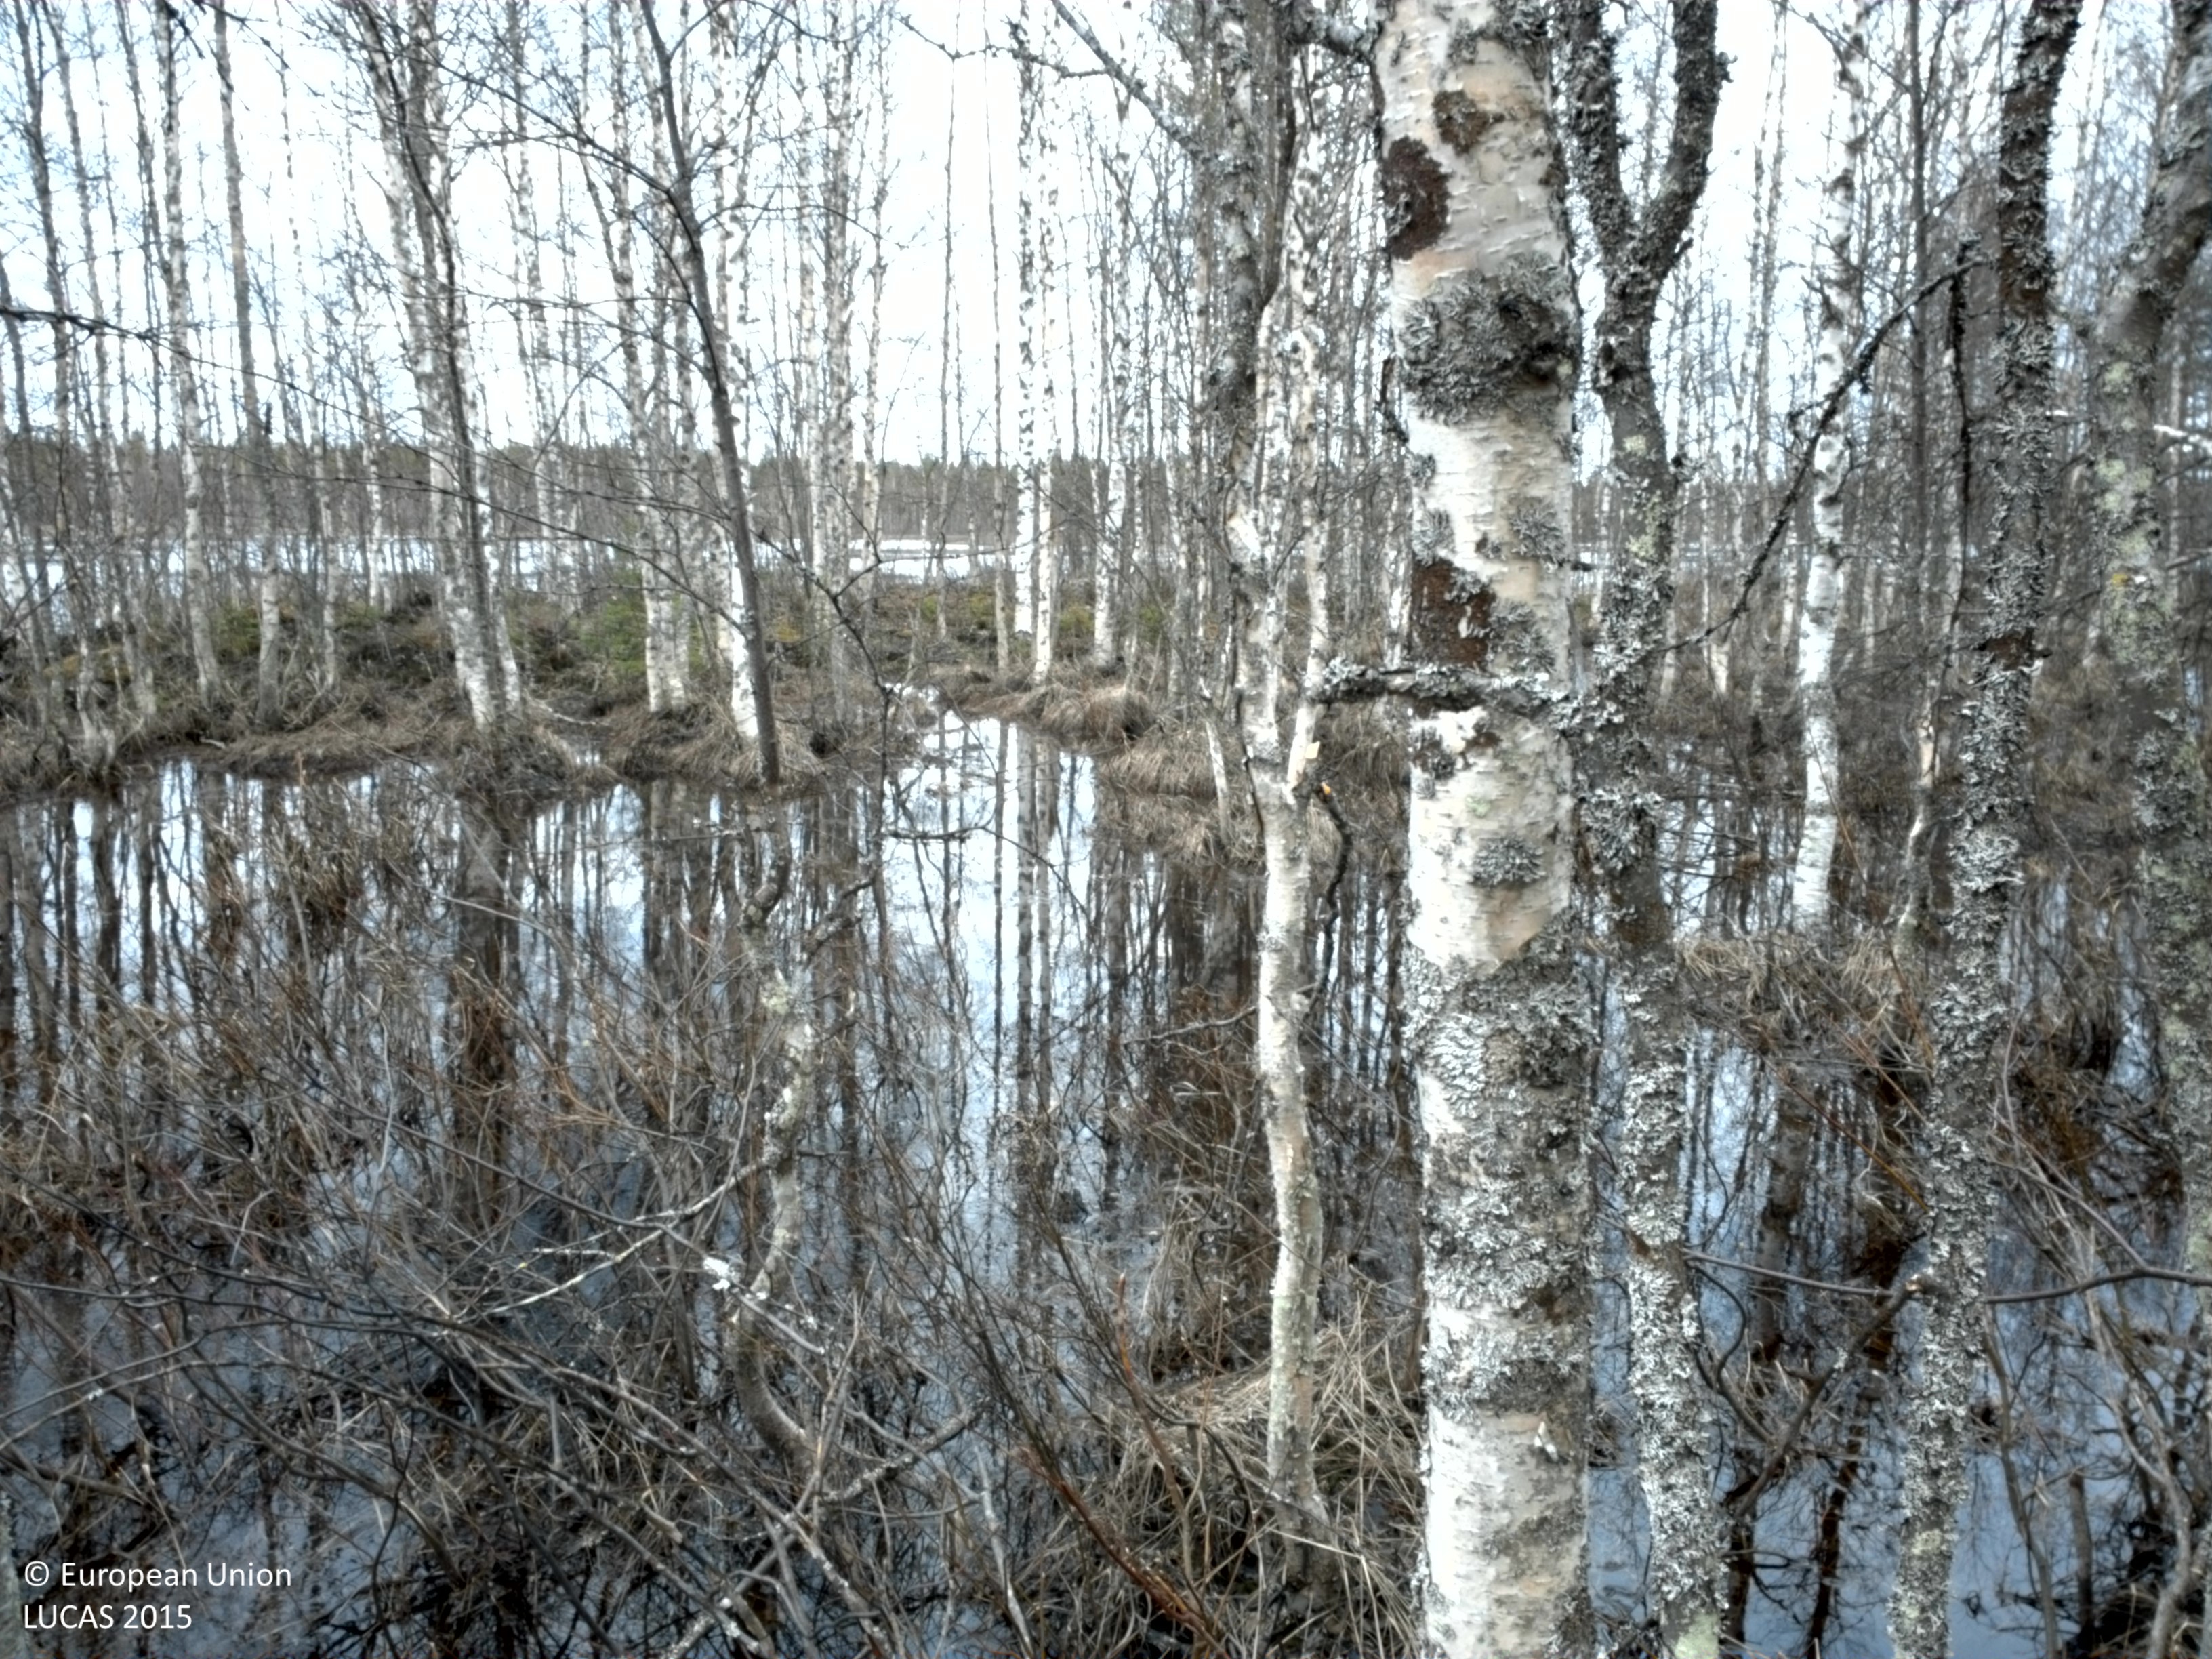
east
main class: Woodland
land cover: Broadleaved woodland
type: mire and swamp forests
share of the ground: 50 - 75 %
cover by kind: broadleaved forest trees 60 %, shrubs 15 %, herbaceous plants 10 %
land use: Semi-natural and natural areas not in use
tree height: > 5 m
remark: Temporary flooded
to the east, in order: Broadleaved woodland; Inland marshes
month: May
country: SE
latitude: 65.8939
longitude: 23.3086
